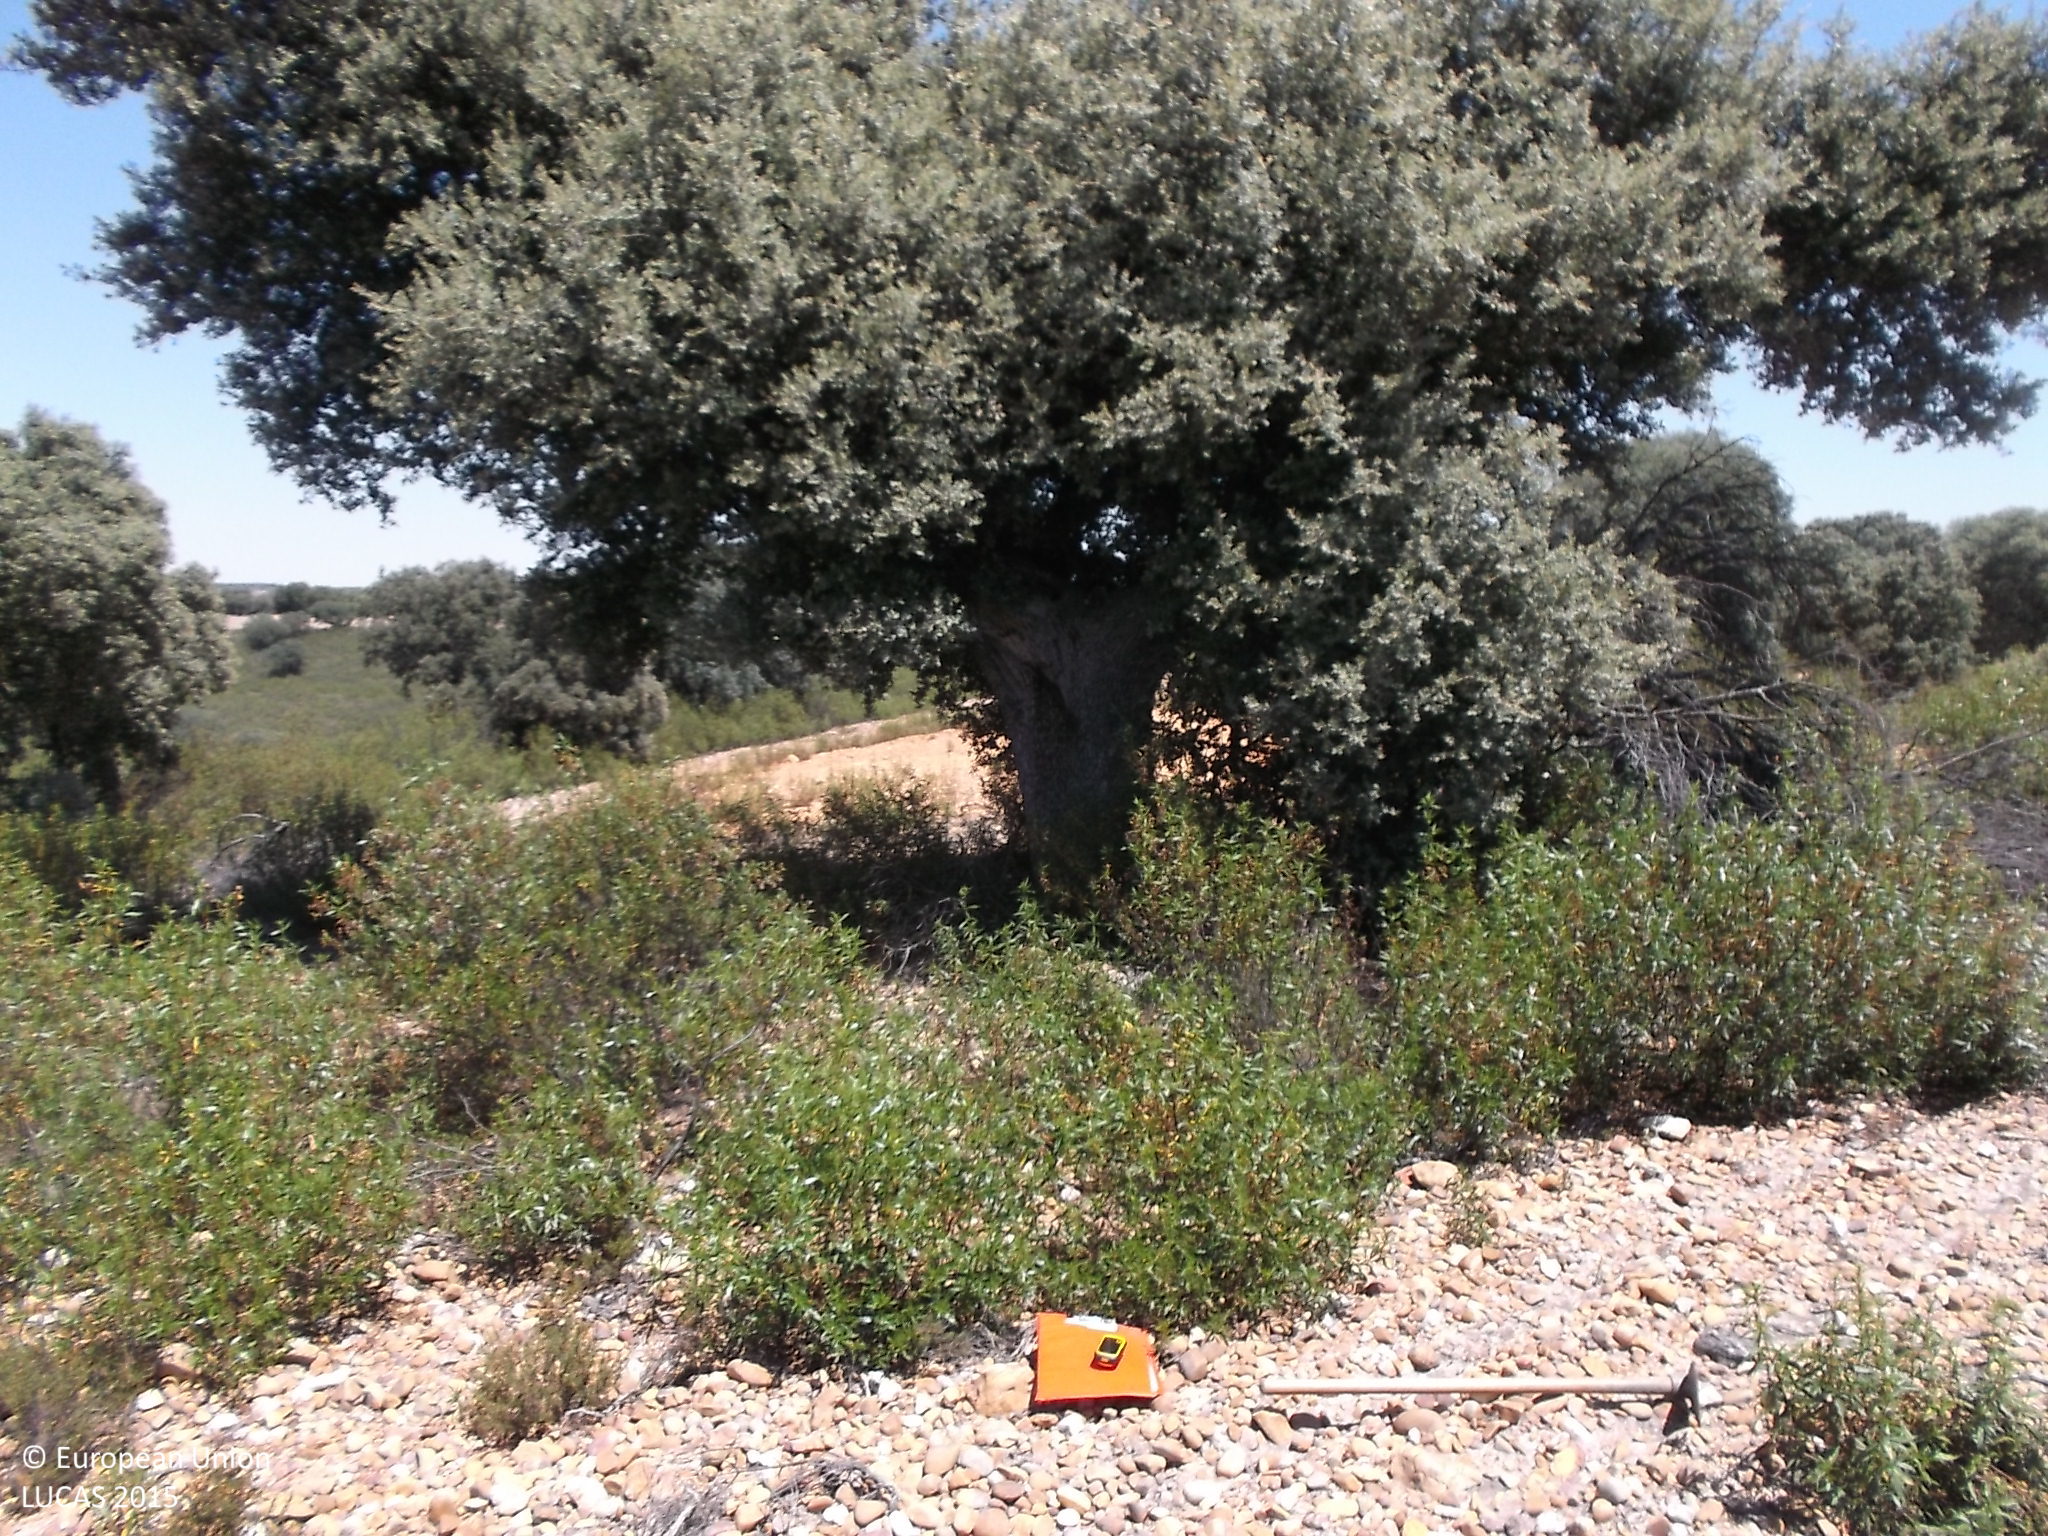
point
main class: Woodland
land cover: Broadleaved woodland
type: broadleaved evergreen forest
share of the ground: 10 - 25 %
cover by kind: unconsolidated bare surface 80 %, broadleaved forest trees 20 %
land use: Forestry
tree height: < 5 m
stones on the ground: 10 - 25 %
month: July
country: ES
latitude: 41.5042
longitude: -5.8670
